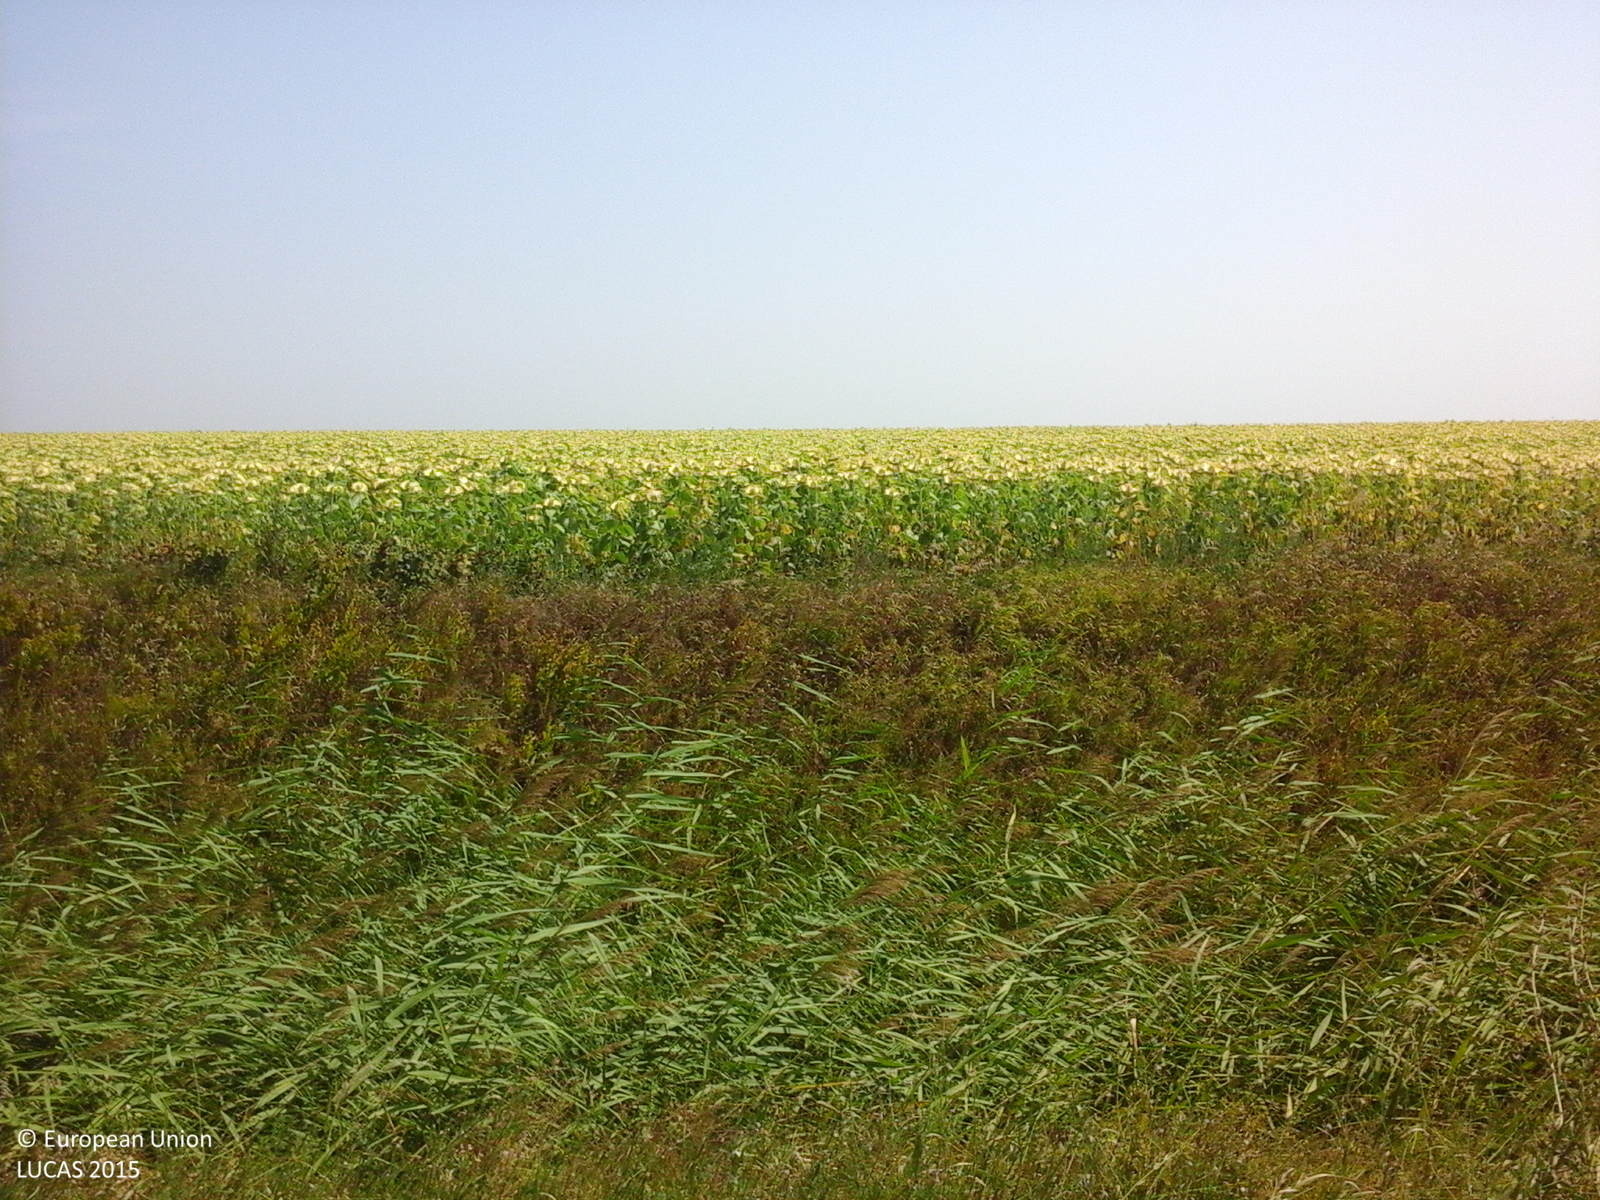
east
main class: Cropland
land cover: Sunflower
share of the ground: > 75 %
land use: Agriculture (excluding fallow land and kitchen gardens)
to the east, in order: Sunflower; Grass margins; Tracks; Spontaneously vegetated surfaces; Ditches and canals; Spontaneously vegetated surfaces
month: August
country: RO
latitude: 44.9325
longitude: 26.7120
